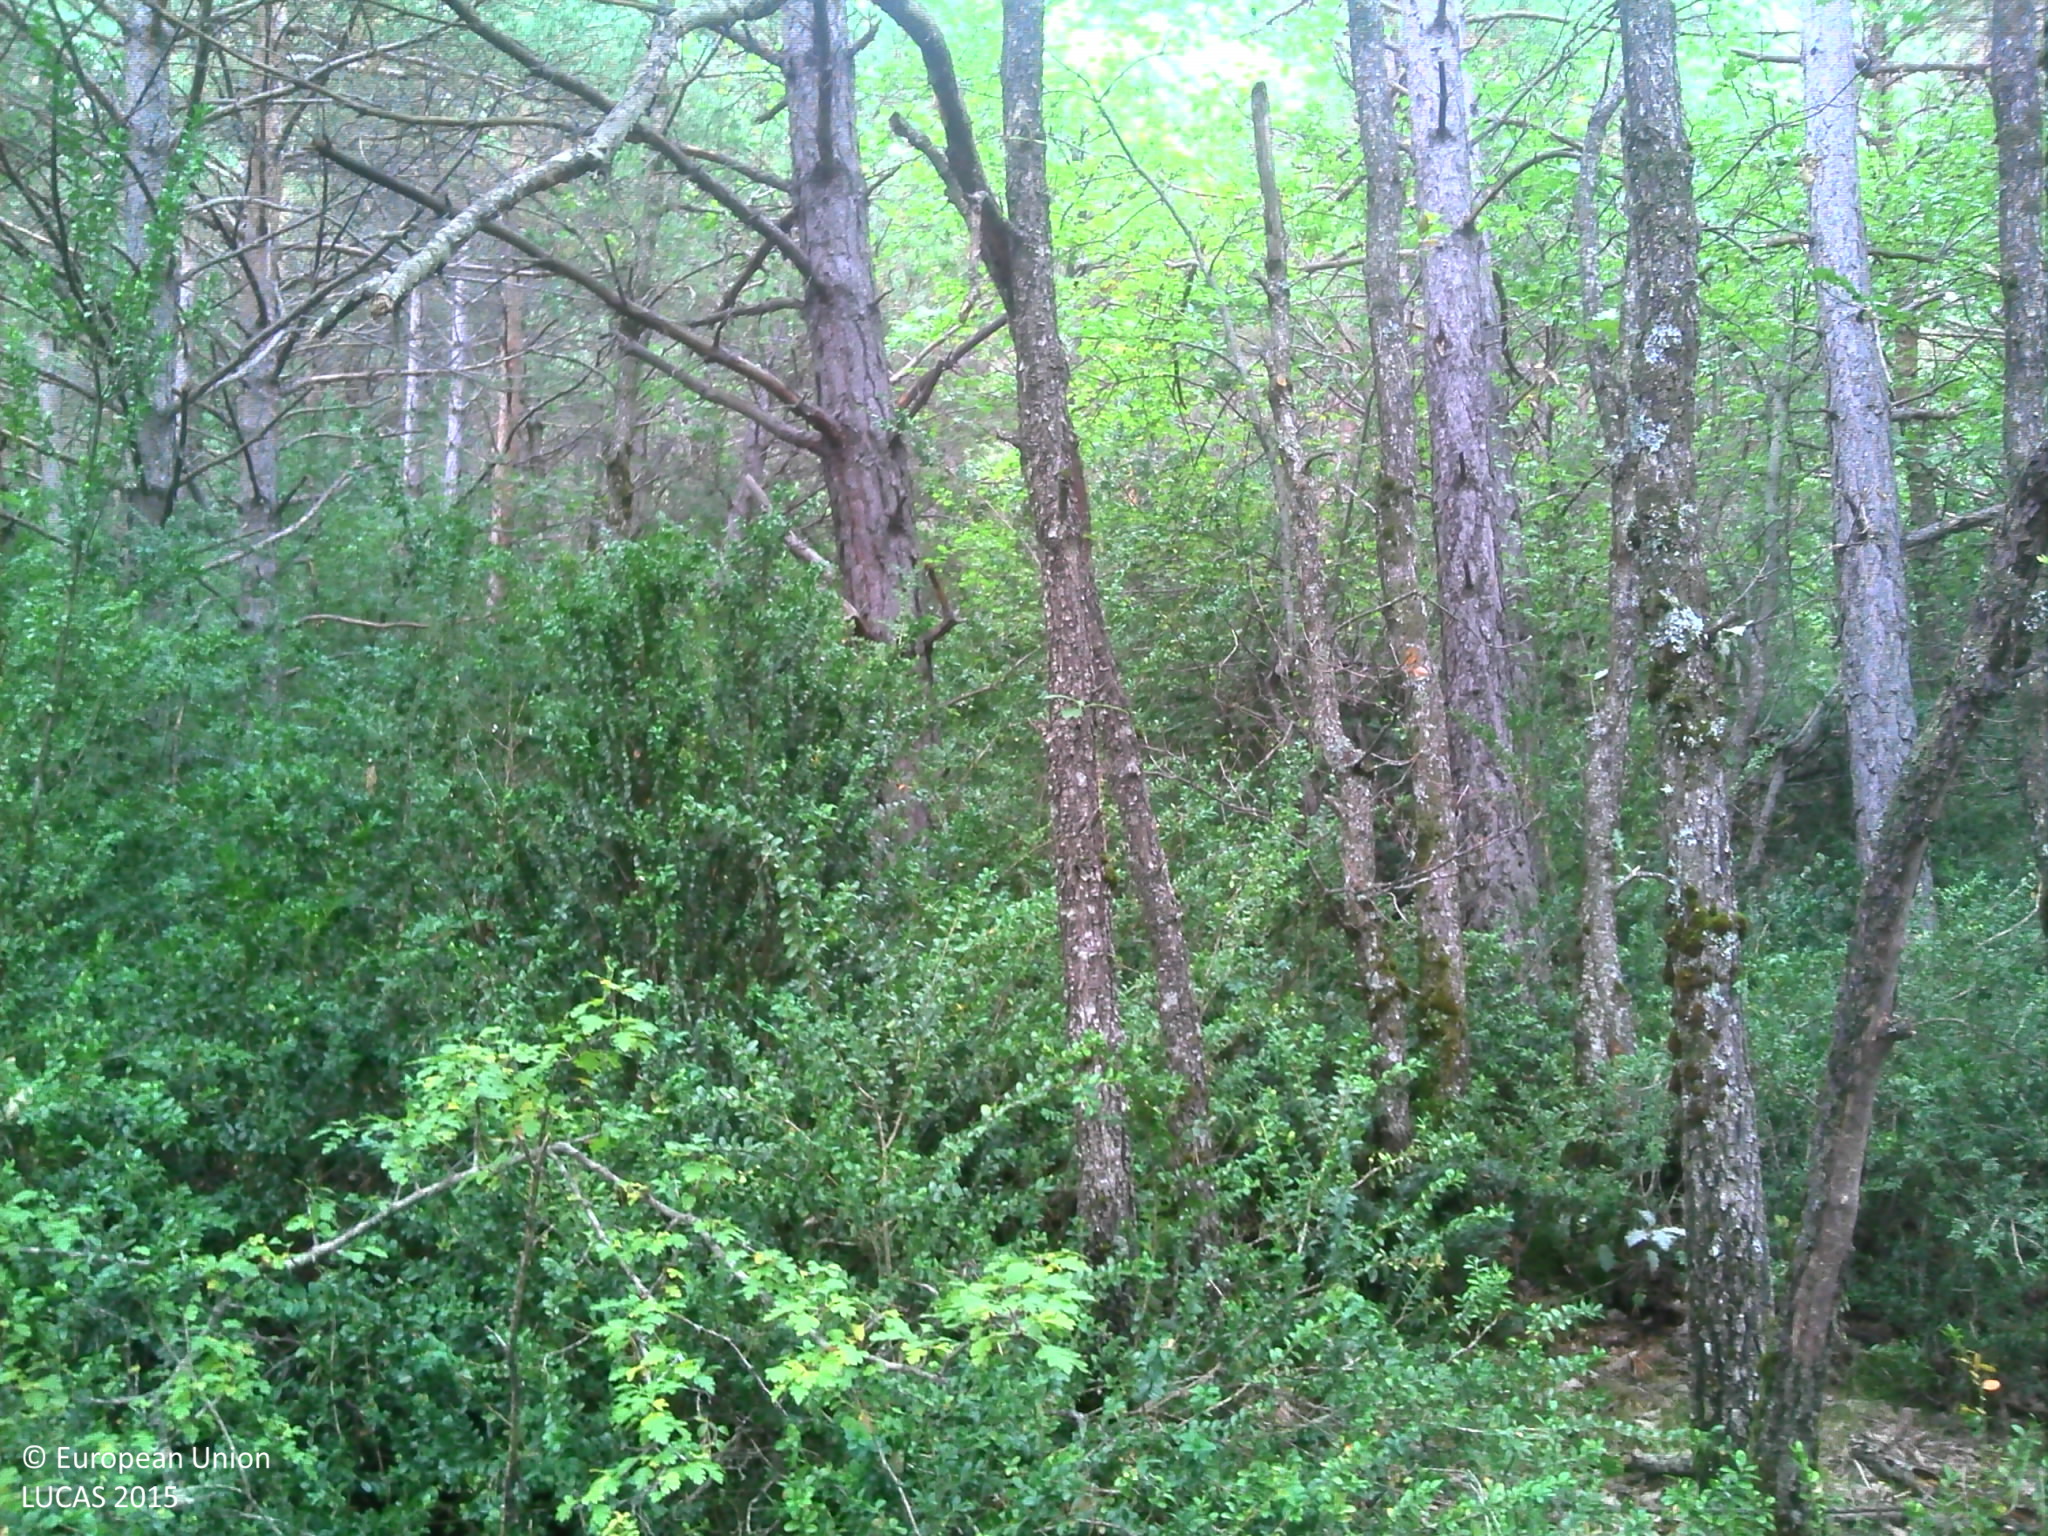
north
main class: Woodland
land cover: Pine dominated mixed woodland
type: alpine coniferous forest
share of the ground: > 75 %
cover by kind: broadleaved forest trees 50 %, coniferous forest trees 20 %, shrubs 20 %, herbaceous plants 10 %
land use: Forestry
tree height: > 5 m
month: September
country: FR
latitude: 44.5987
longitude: 5.5596
